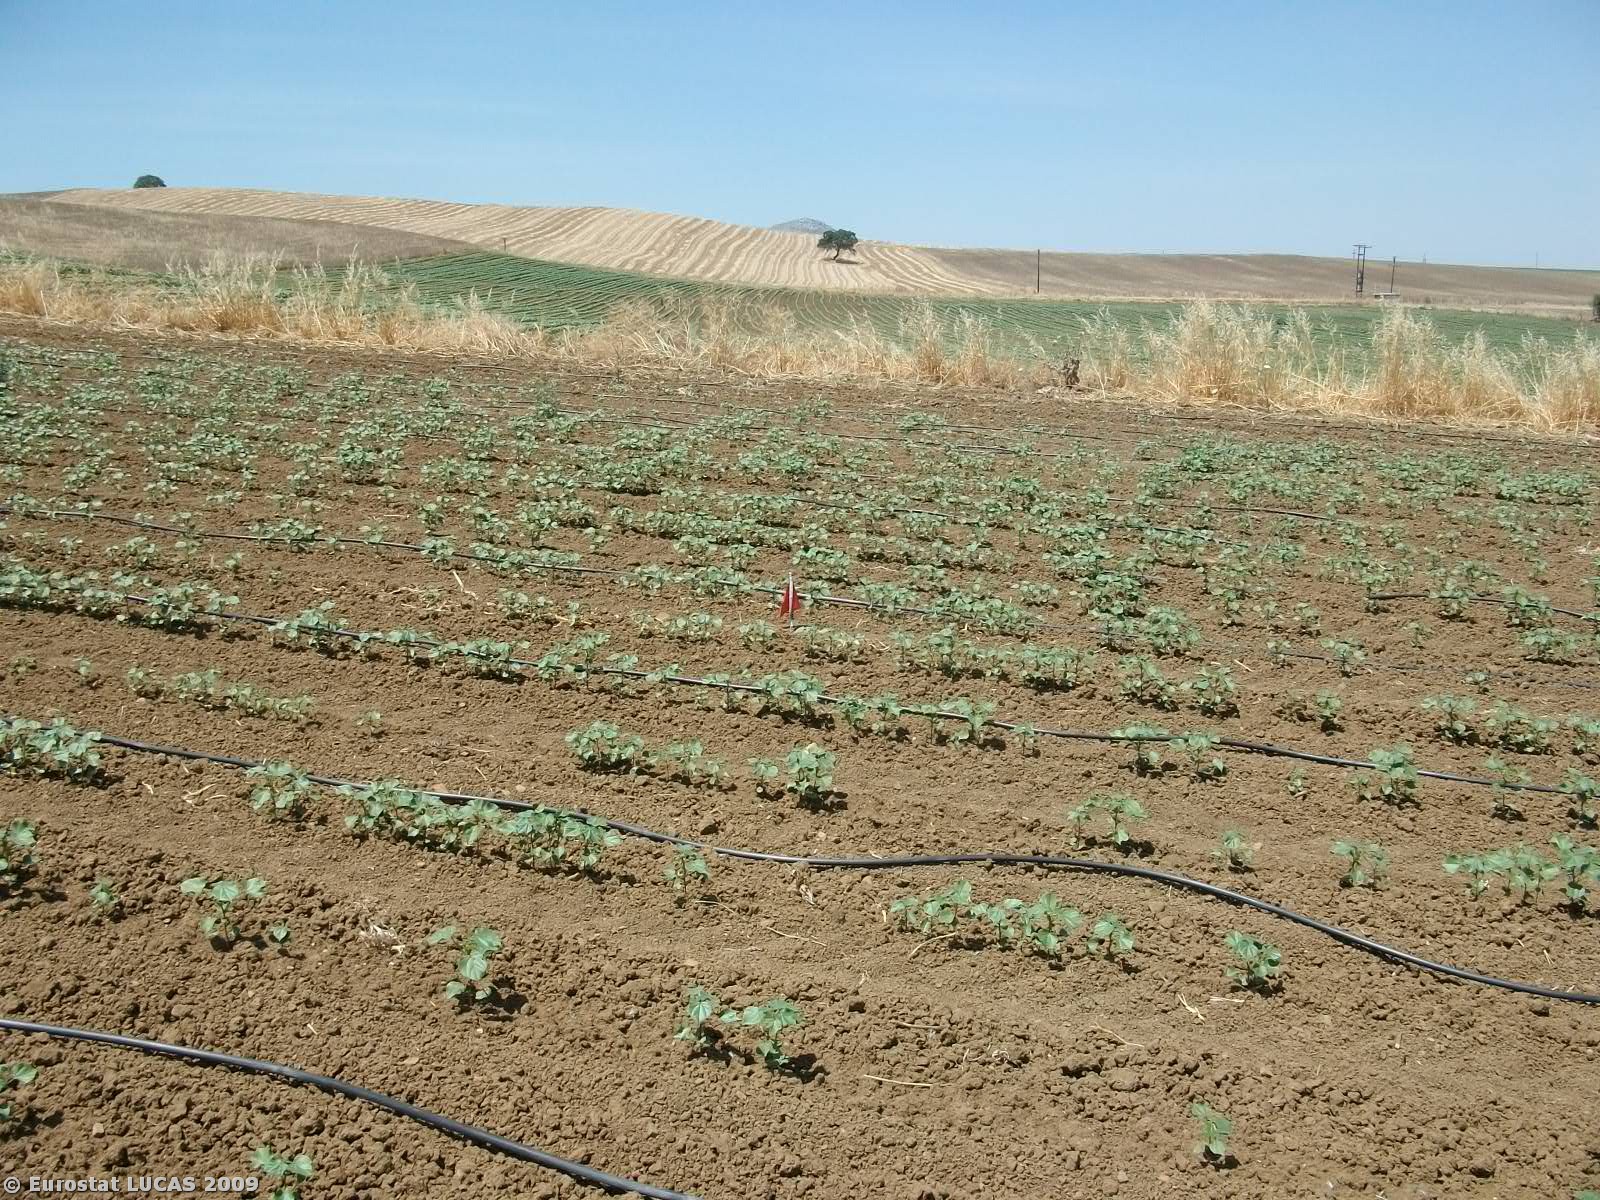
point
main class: Cropland
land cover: Cotton
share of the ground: < 10 %
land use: Agriculture (excluding fallow land and kitchen gardens)
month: May
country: GR
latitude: 39.3031
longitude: 22.4754
